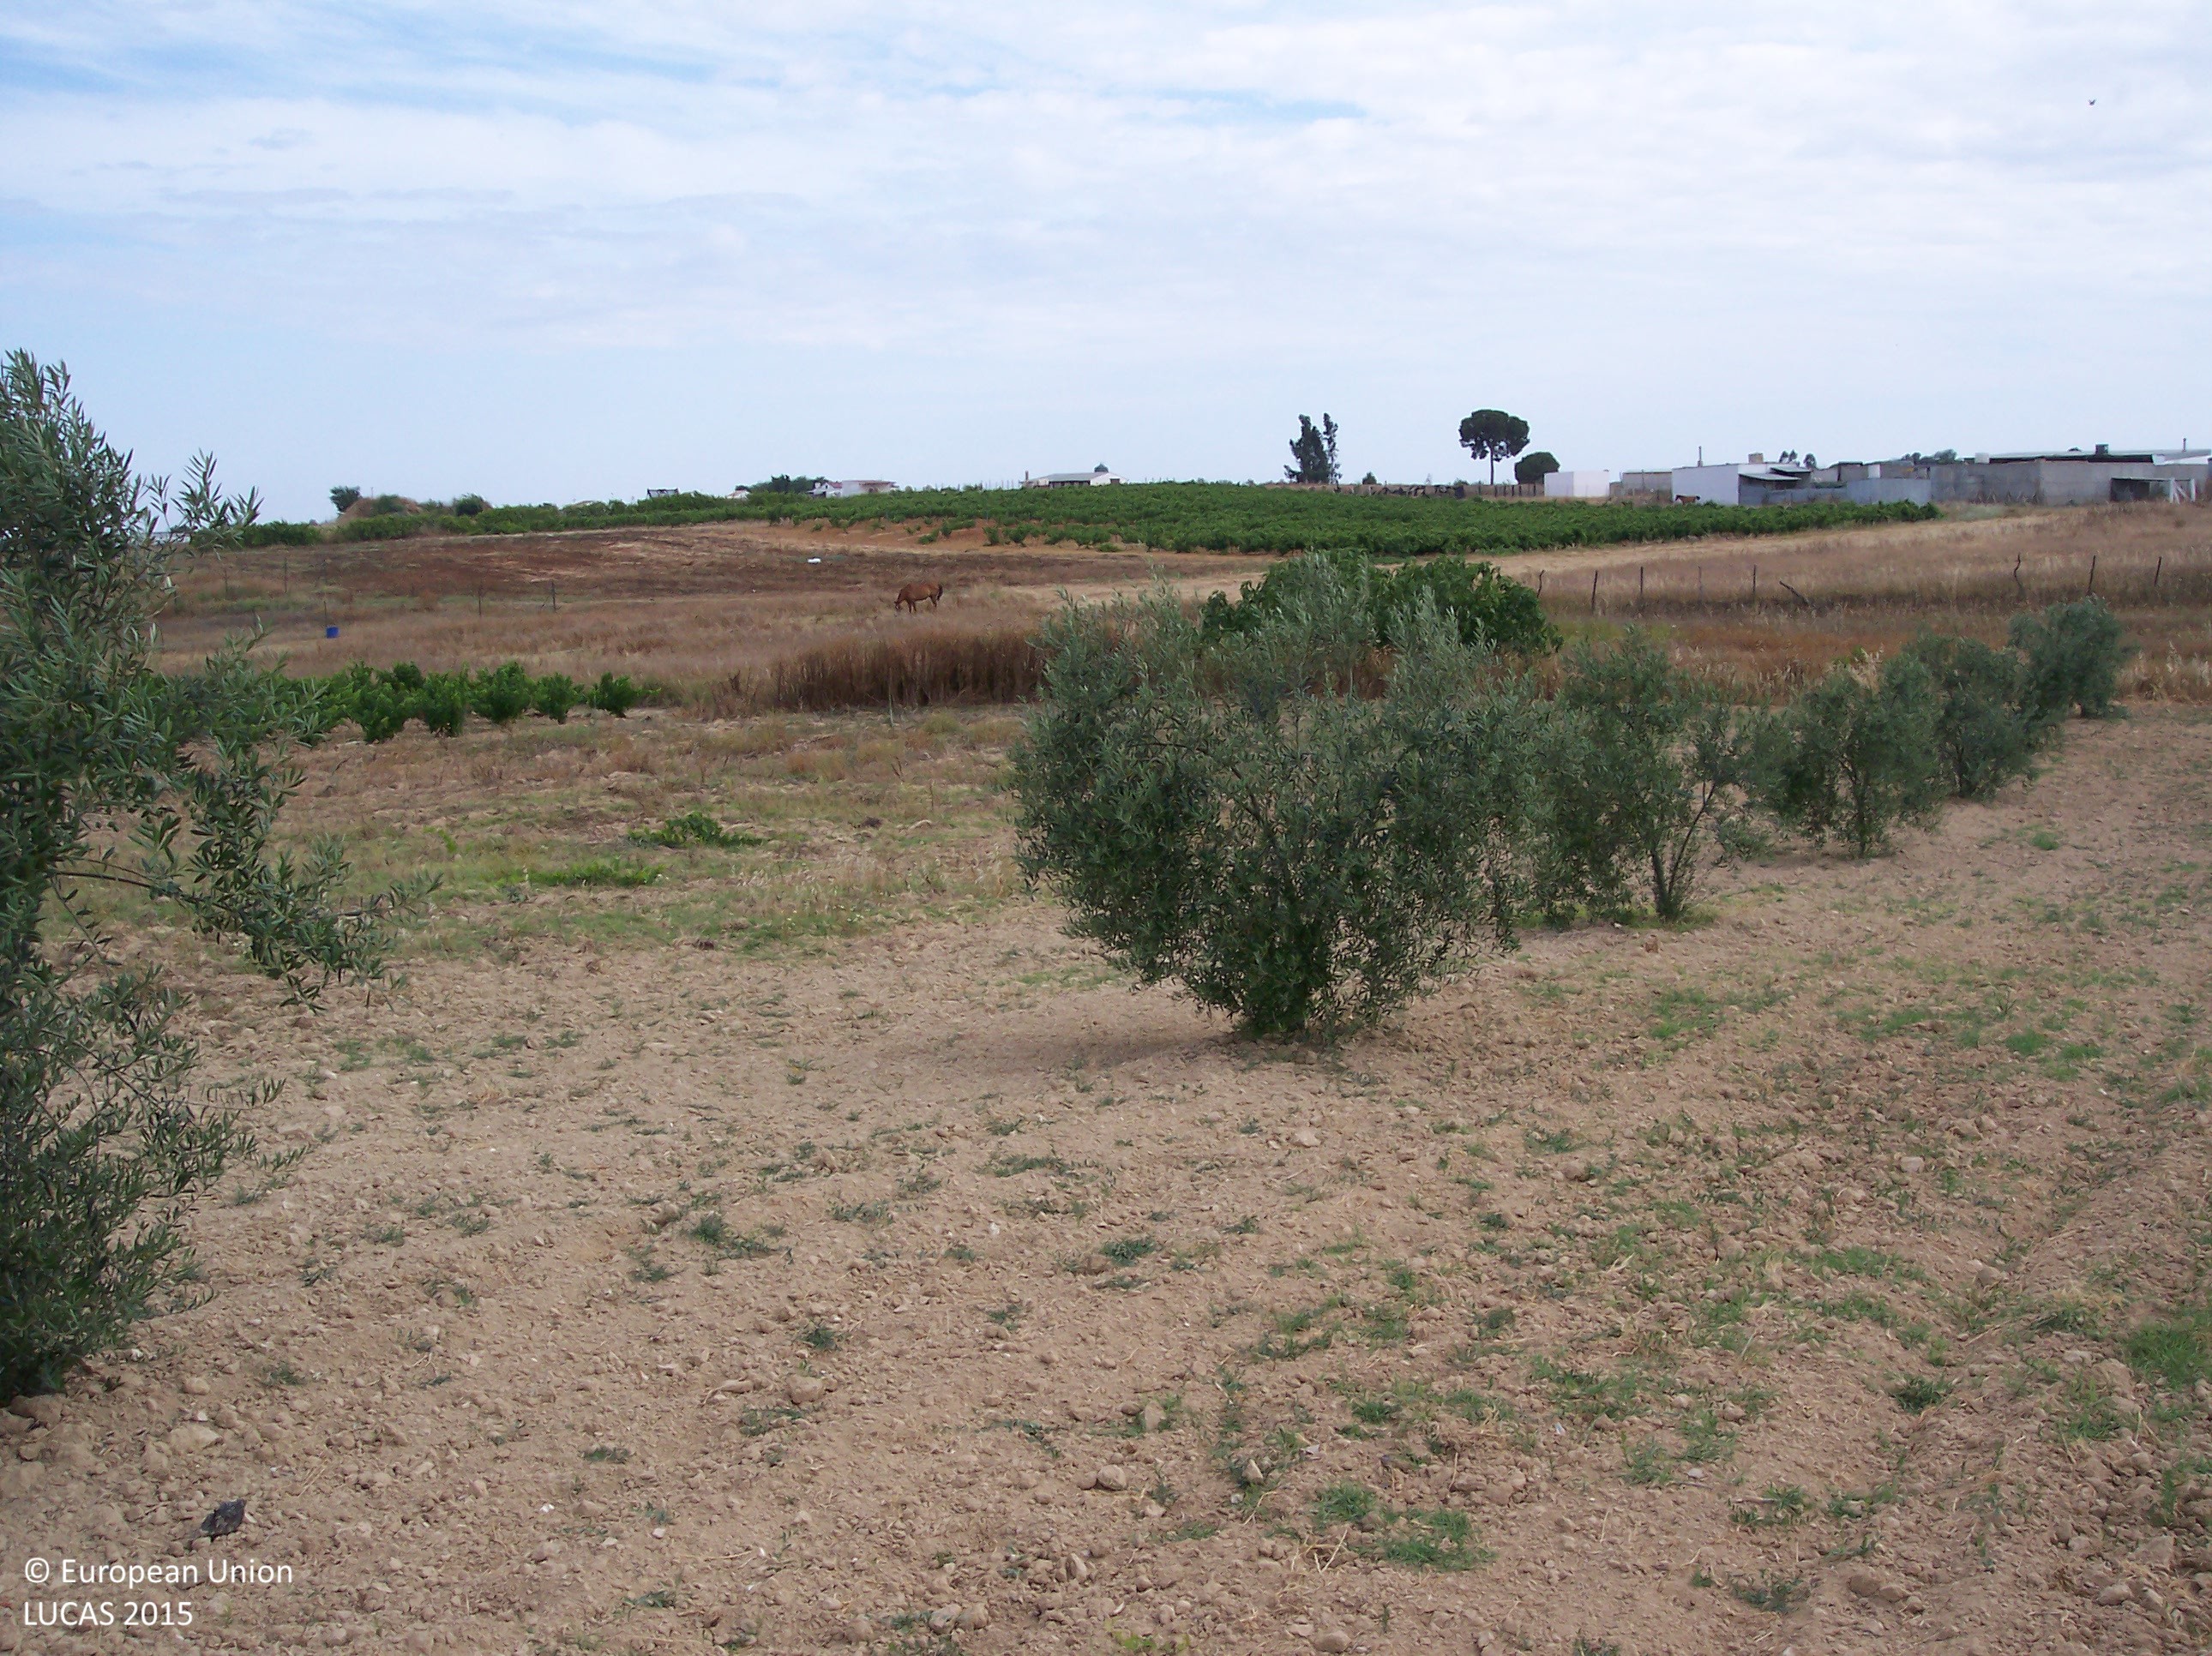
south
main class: Cropland
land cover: Olive groves
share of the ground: 10 - 25 %
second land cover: Other bare soil
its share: > 75 %
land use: Agriculture (excluding fallow land and kitchen gardens)
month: June
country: ES
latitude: 37.2548
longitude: -6.5023
